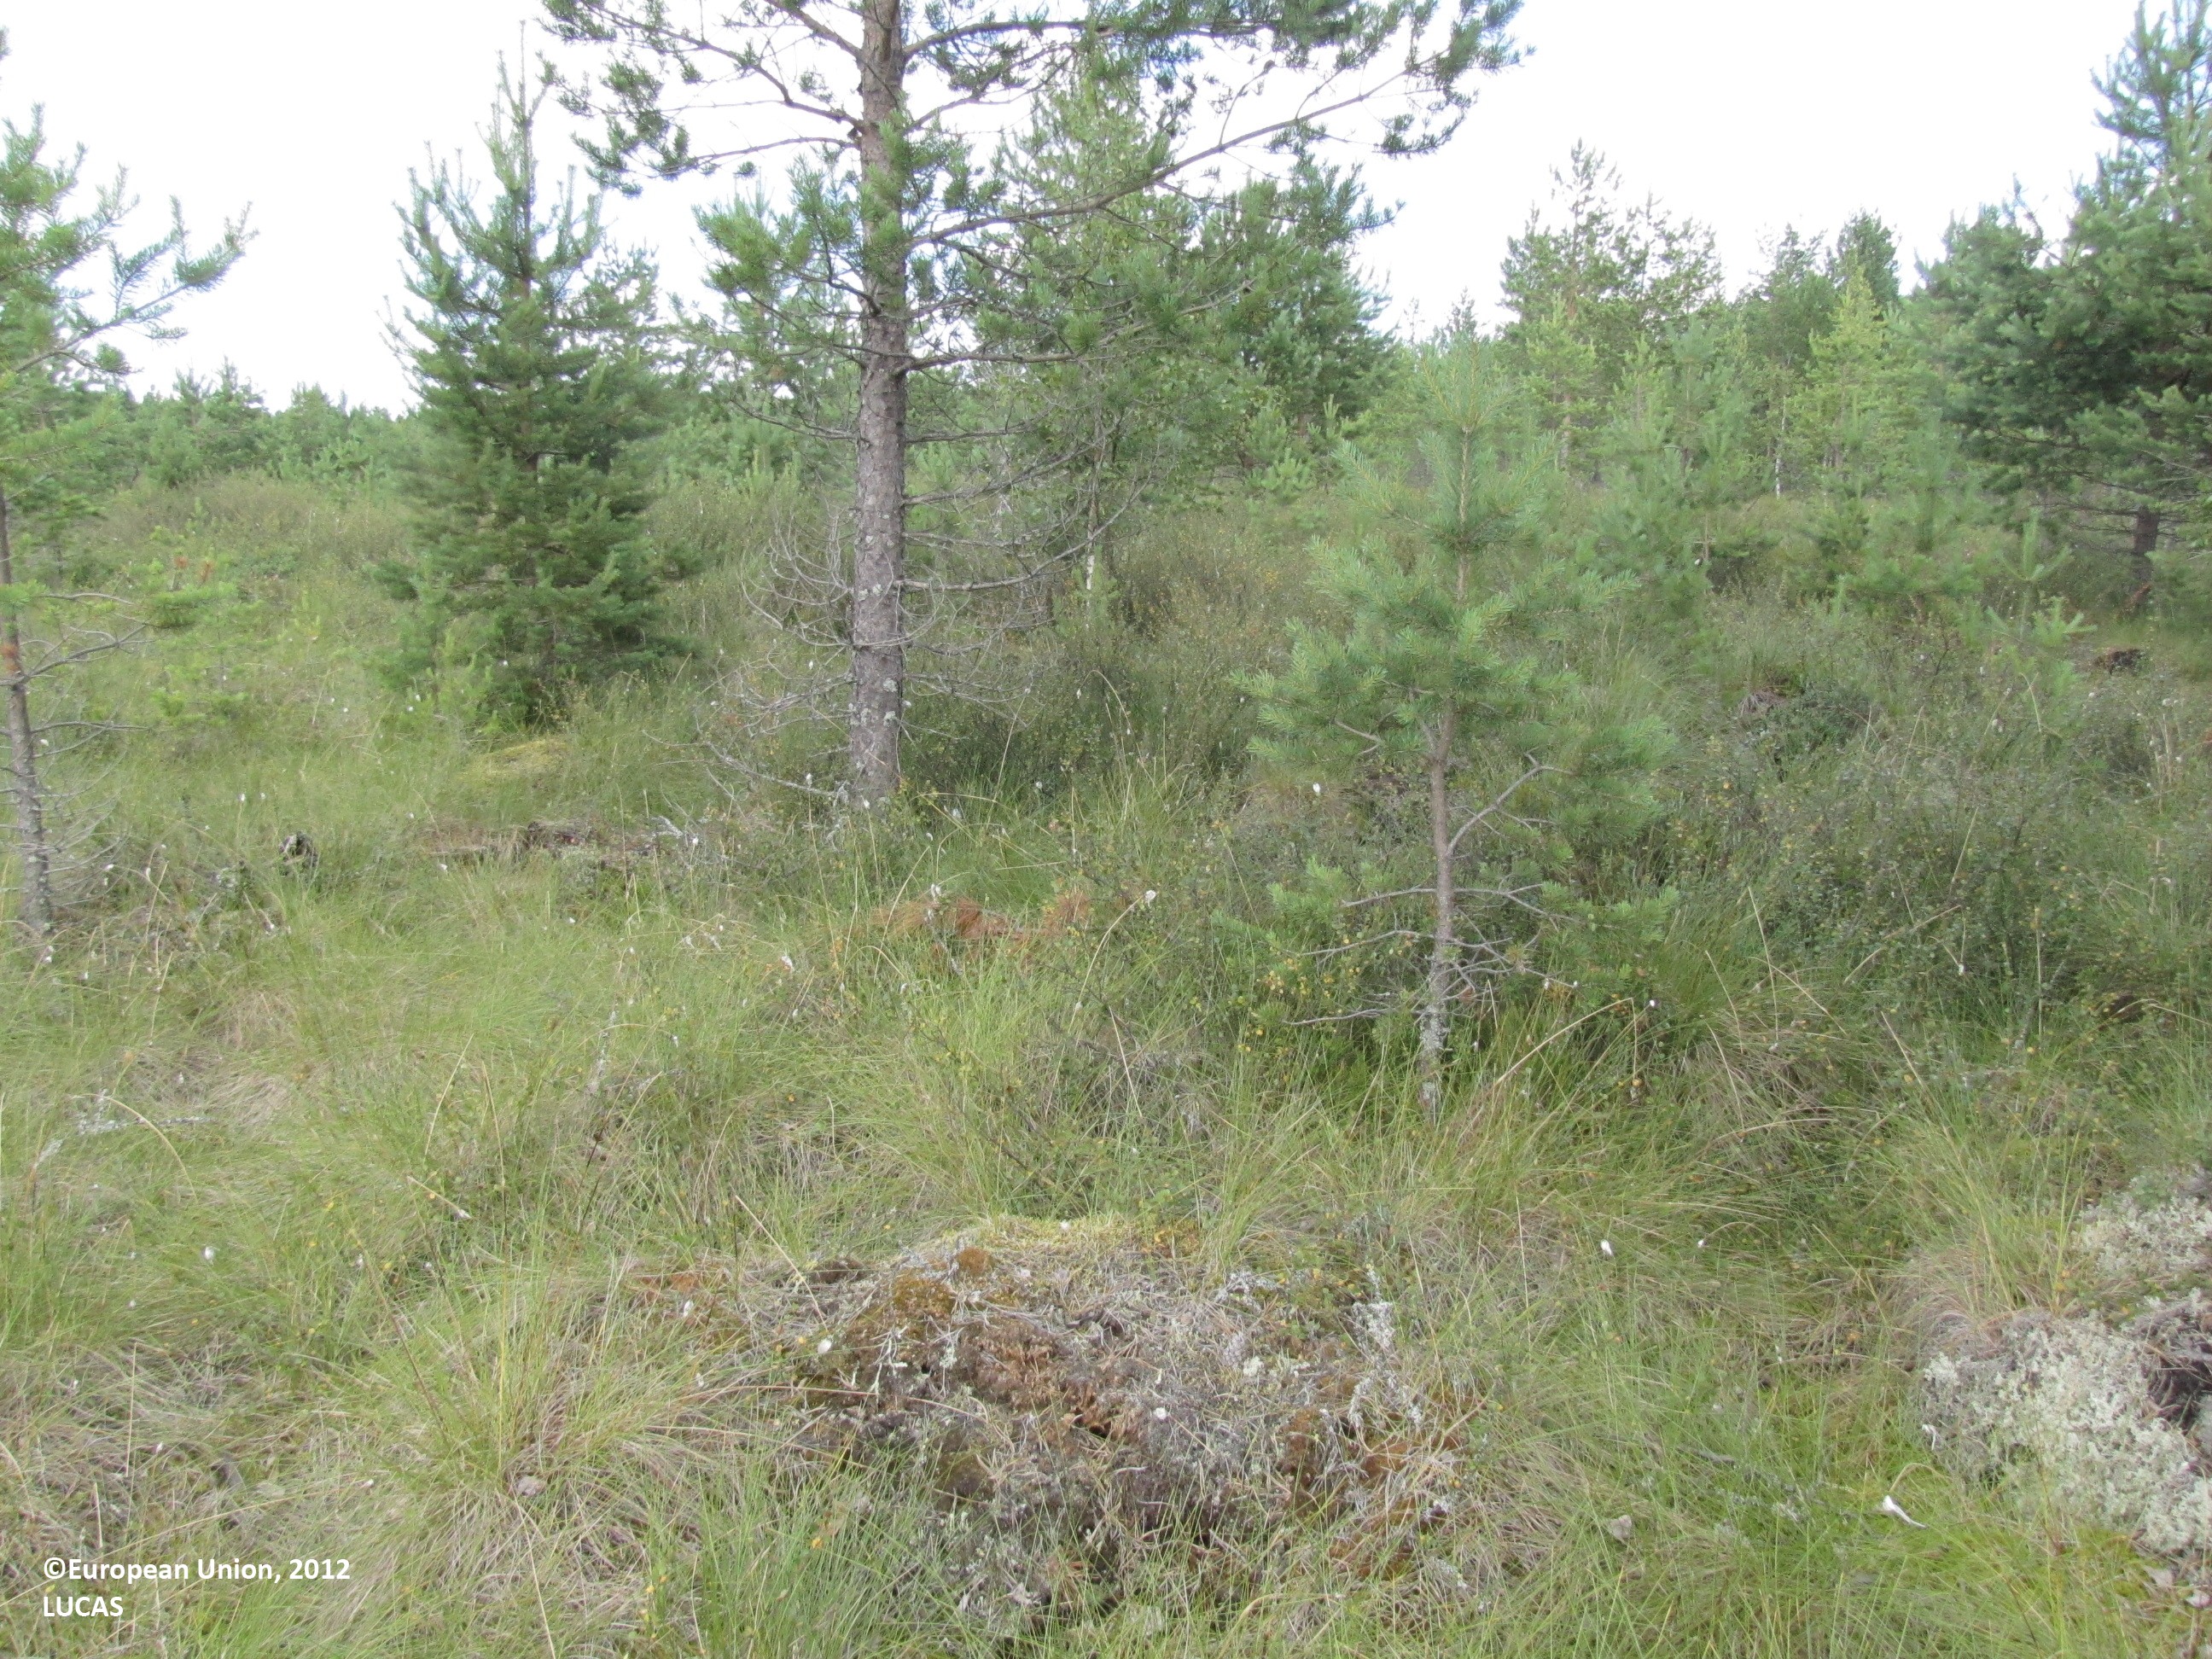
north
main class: Woodland
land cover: Pine dominated coniferous woodland
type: mire and swamp forests
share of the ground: 25 - 50 %
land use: Forestry
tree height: < 5 m
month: July
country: FI
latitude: 62.2750
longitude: 23.3067
